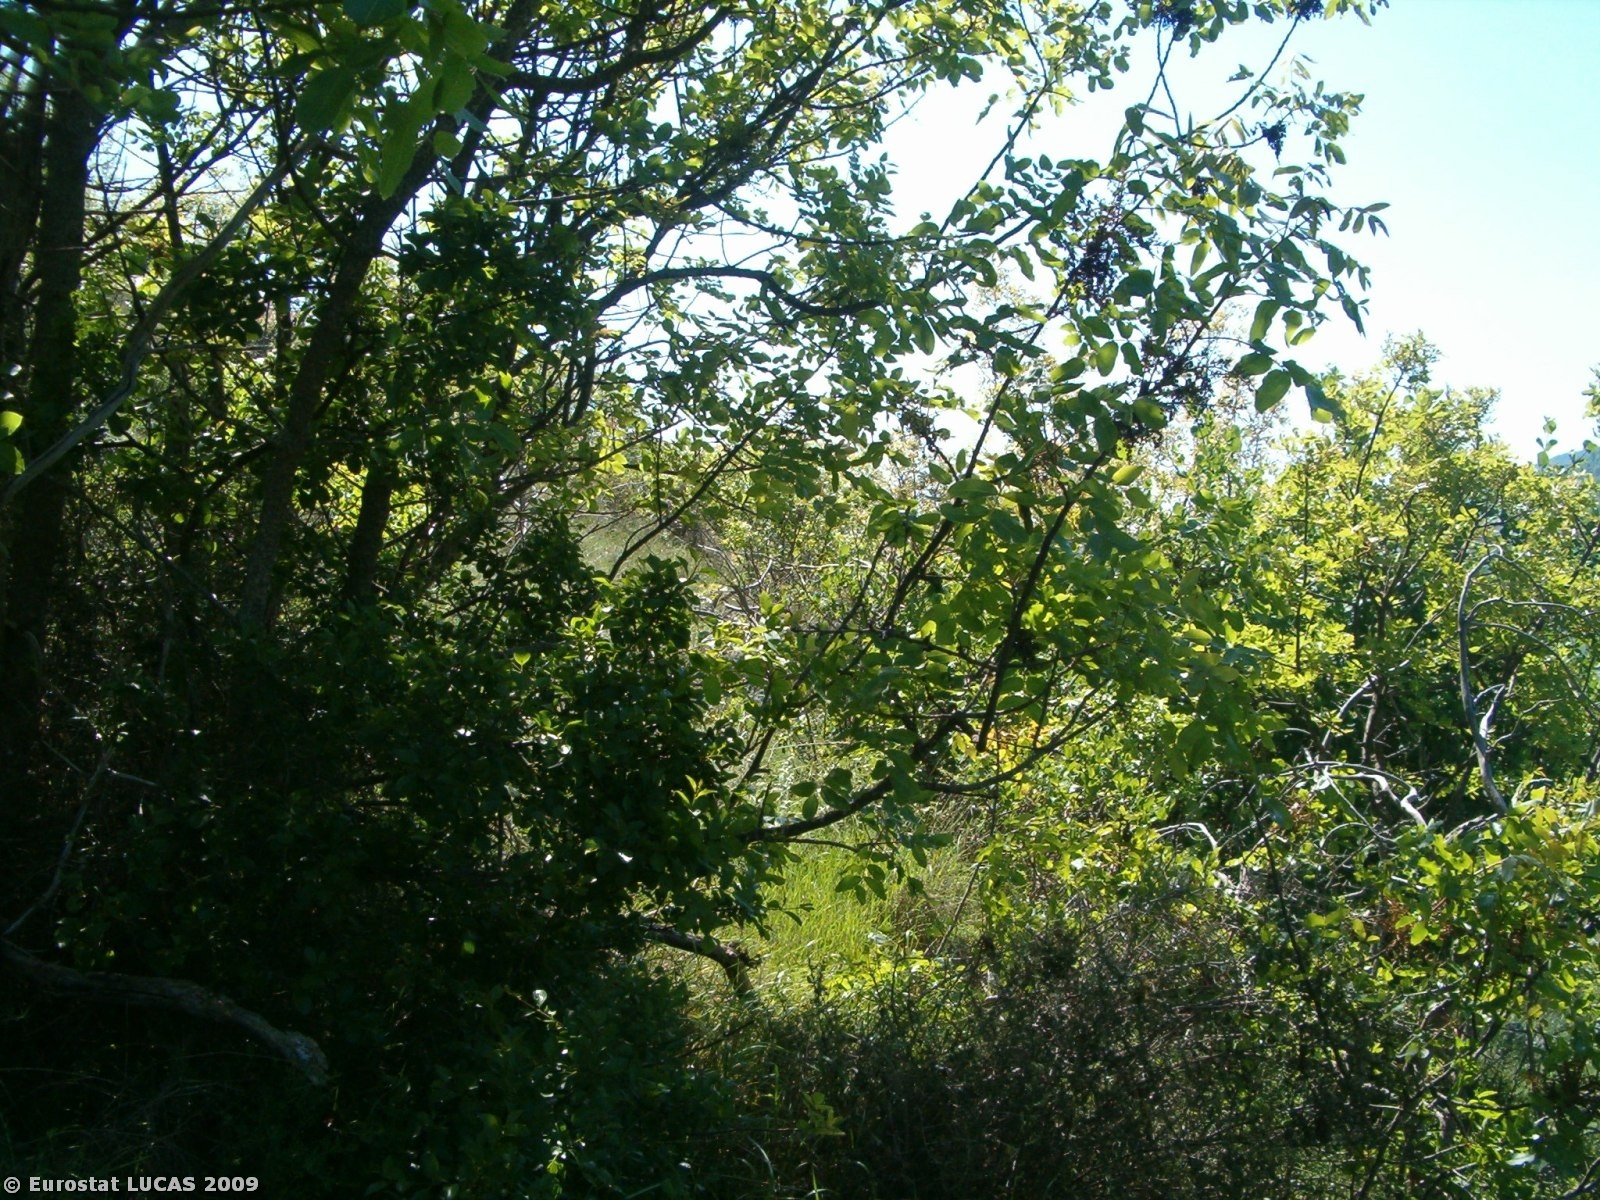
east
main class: Shrubland
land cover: Shrubland without tree cover
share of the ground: > 75 %
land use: Unused
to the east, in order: Shrubland without tree cover
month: May
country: IT
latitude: 42.1117
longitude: 13.3145
